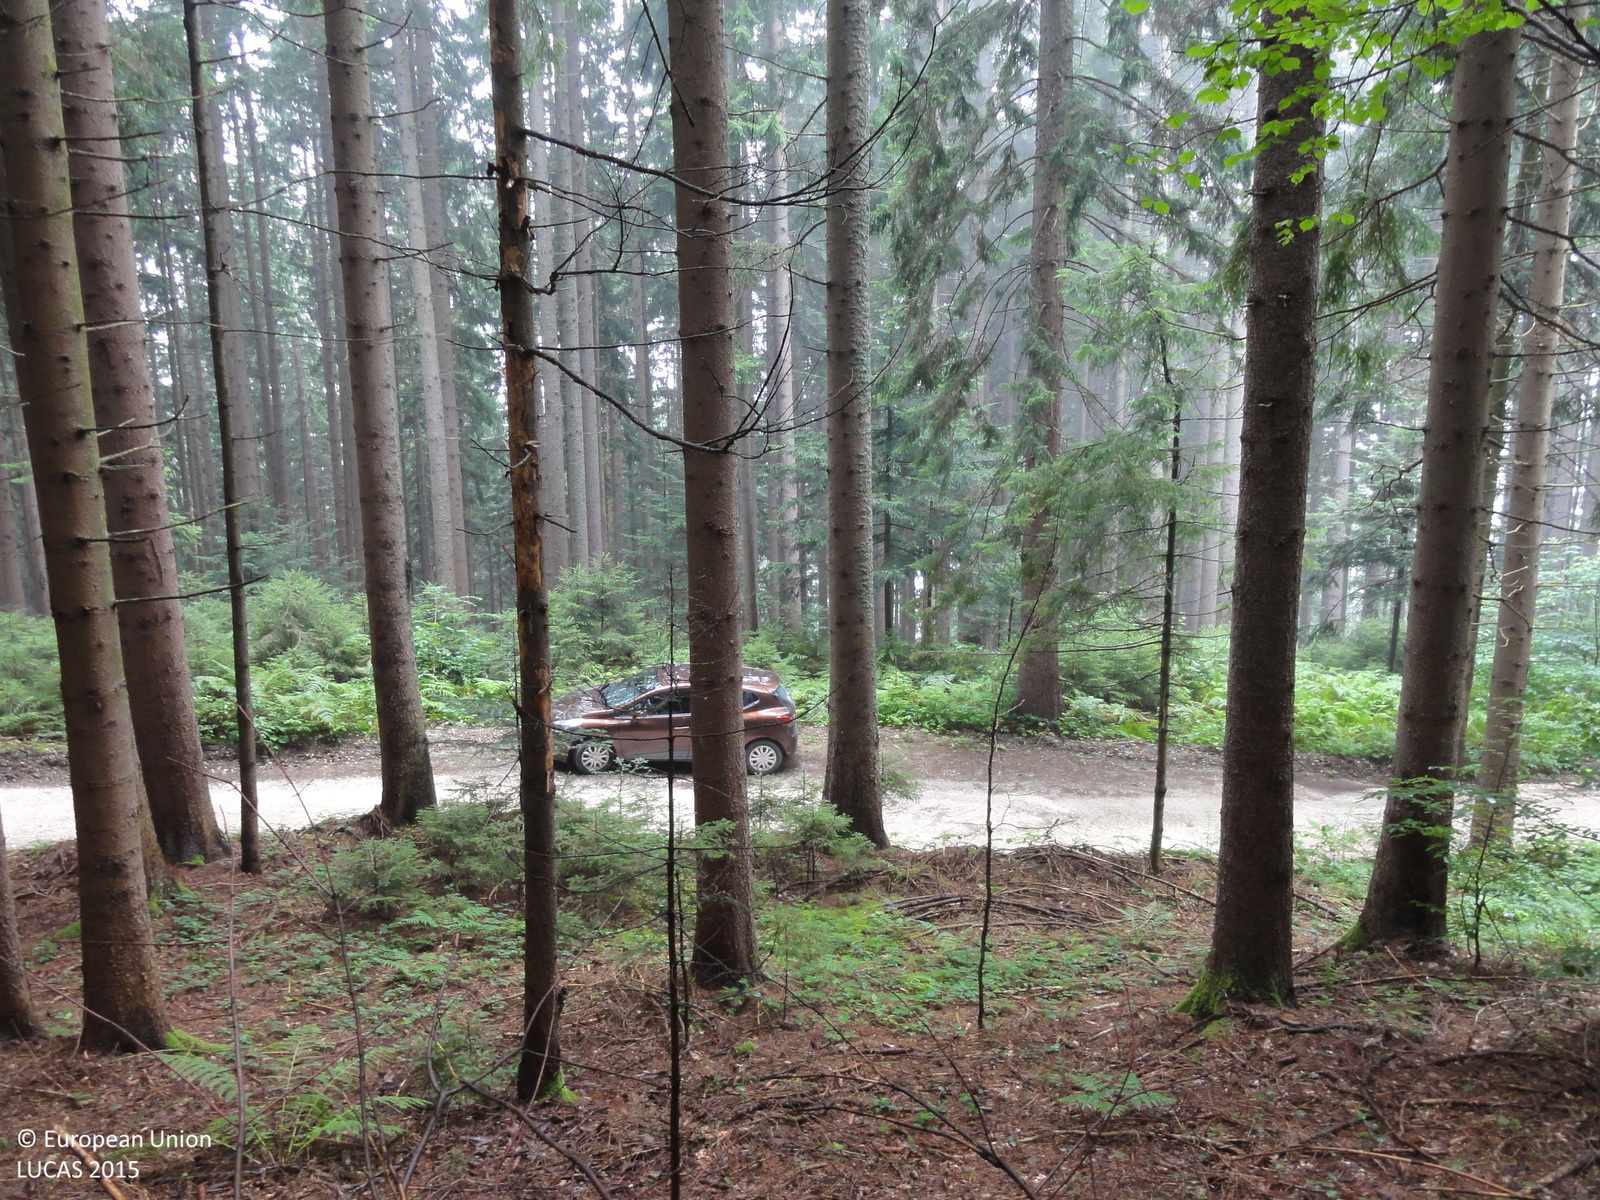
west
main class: Woodland
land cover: Spruce dominated mixed woodland
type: mountainous beech forest
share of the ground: > 75 %
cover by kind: coniferous forest trees 75 %, broadleaved forest trees 25 %
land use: Forestry
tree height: > 5 m
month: August
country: SI
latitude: 46.3689
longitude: 14.8201
